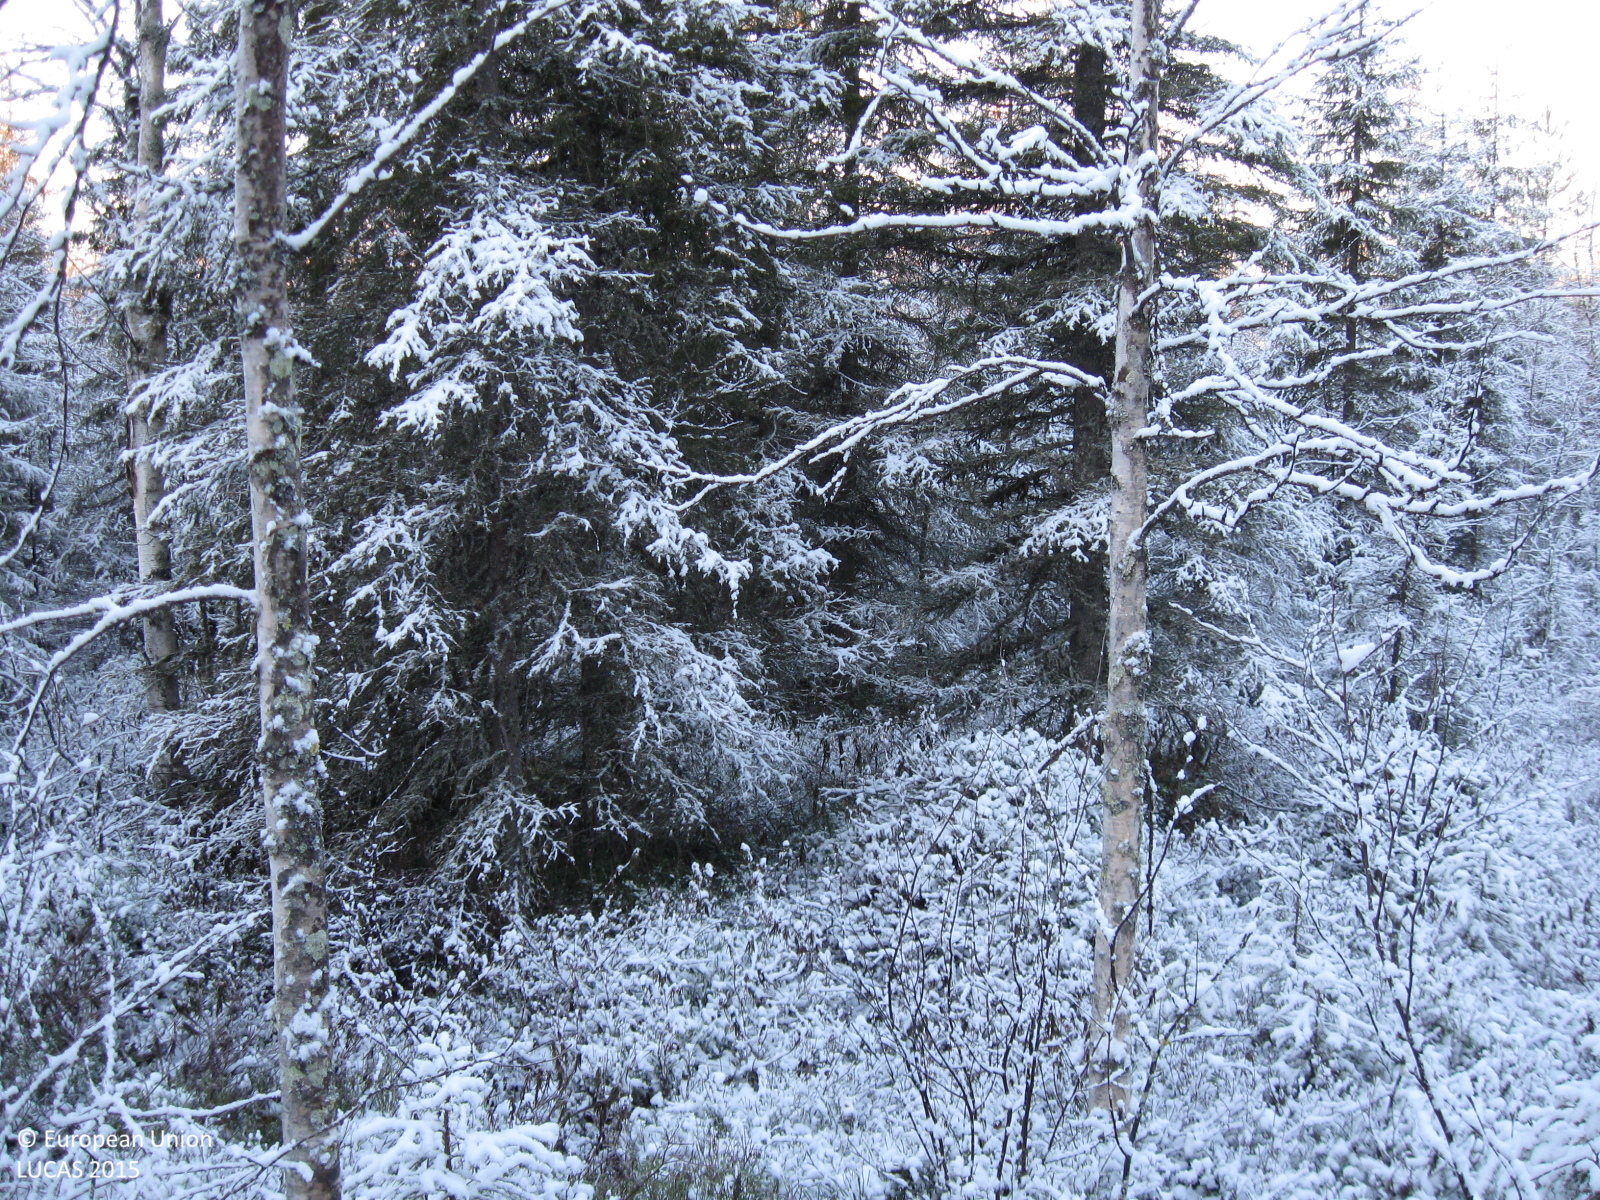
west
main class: Woodland
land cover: Spruce dominated mixed woodland
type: boreal forest
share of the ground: 50 - 75 %
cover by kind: coniferous forest trees 35 %, broadleaved forest trees 25 %, shrubs 20 %, herbaceous plants 10 %, lichens and mosses 10 %
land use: Forestry
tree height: > 5 m
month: October
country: SE
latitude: 66.3430
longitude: 21.4659
